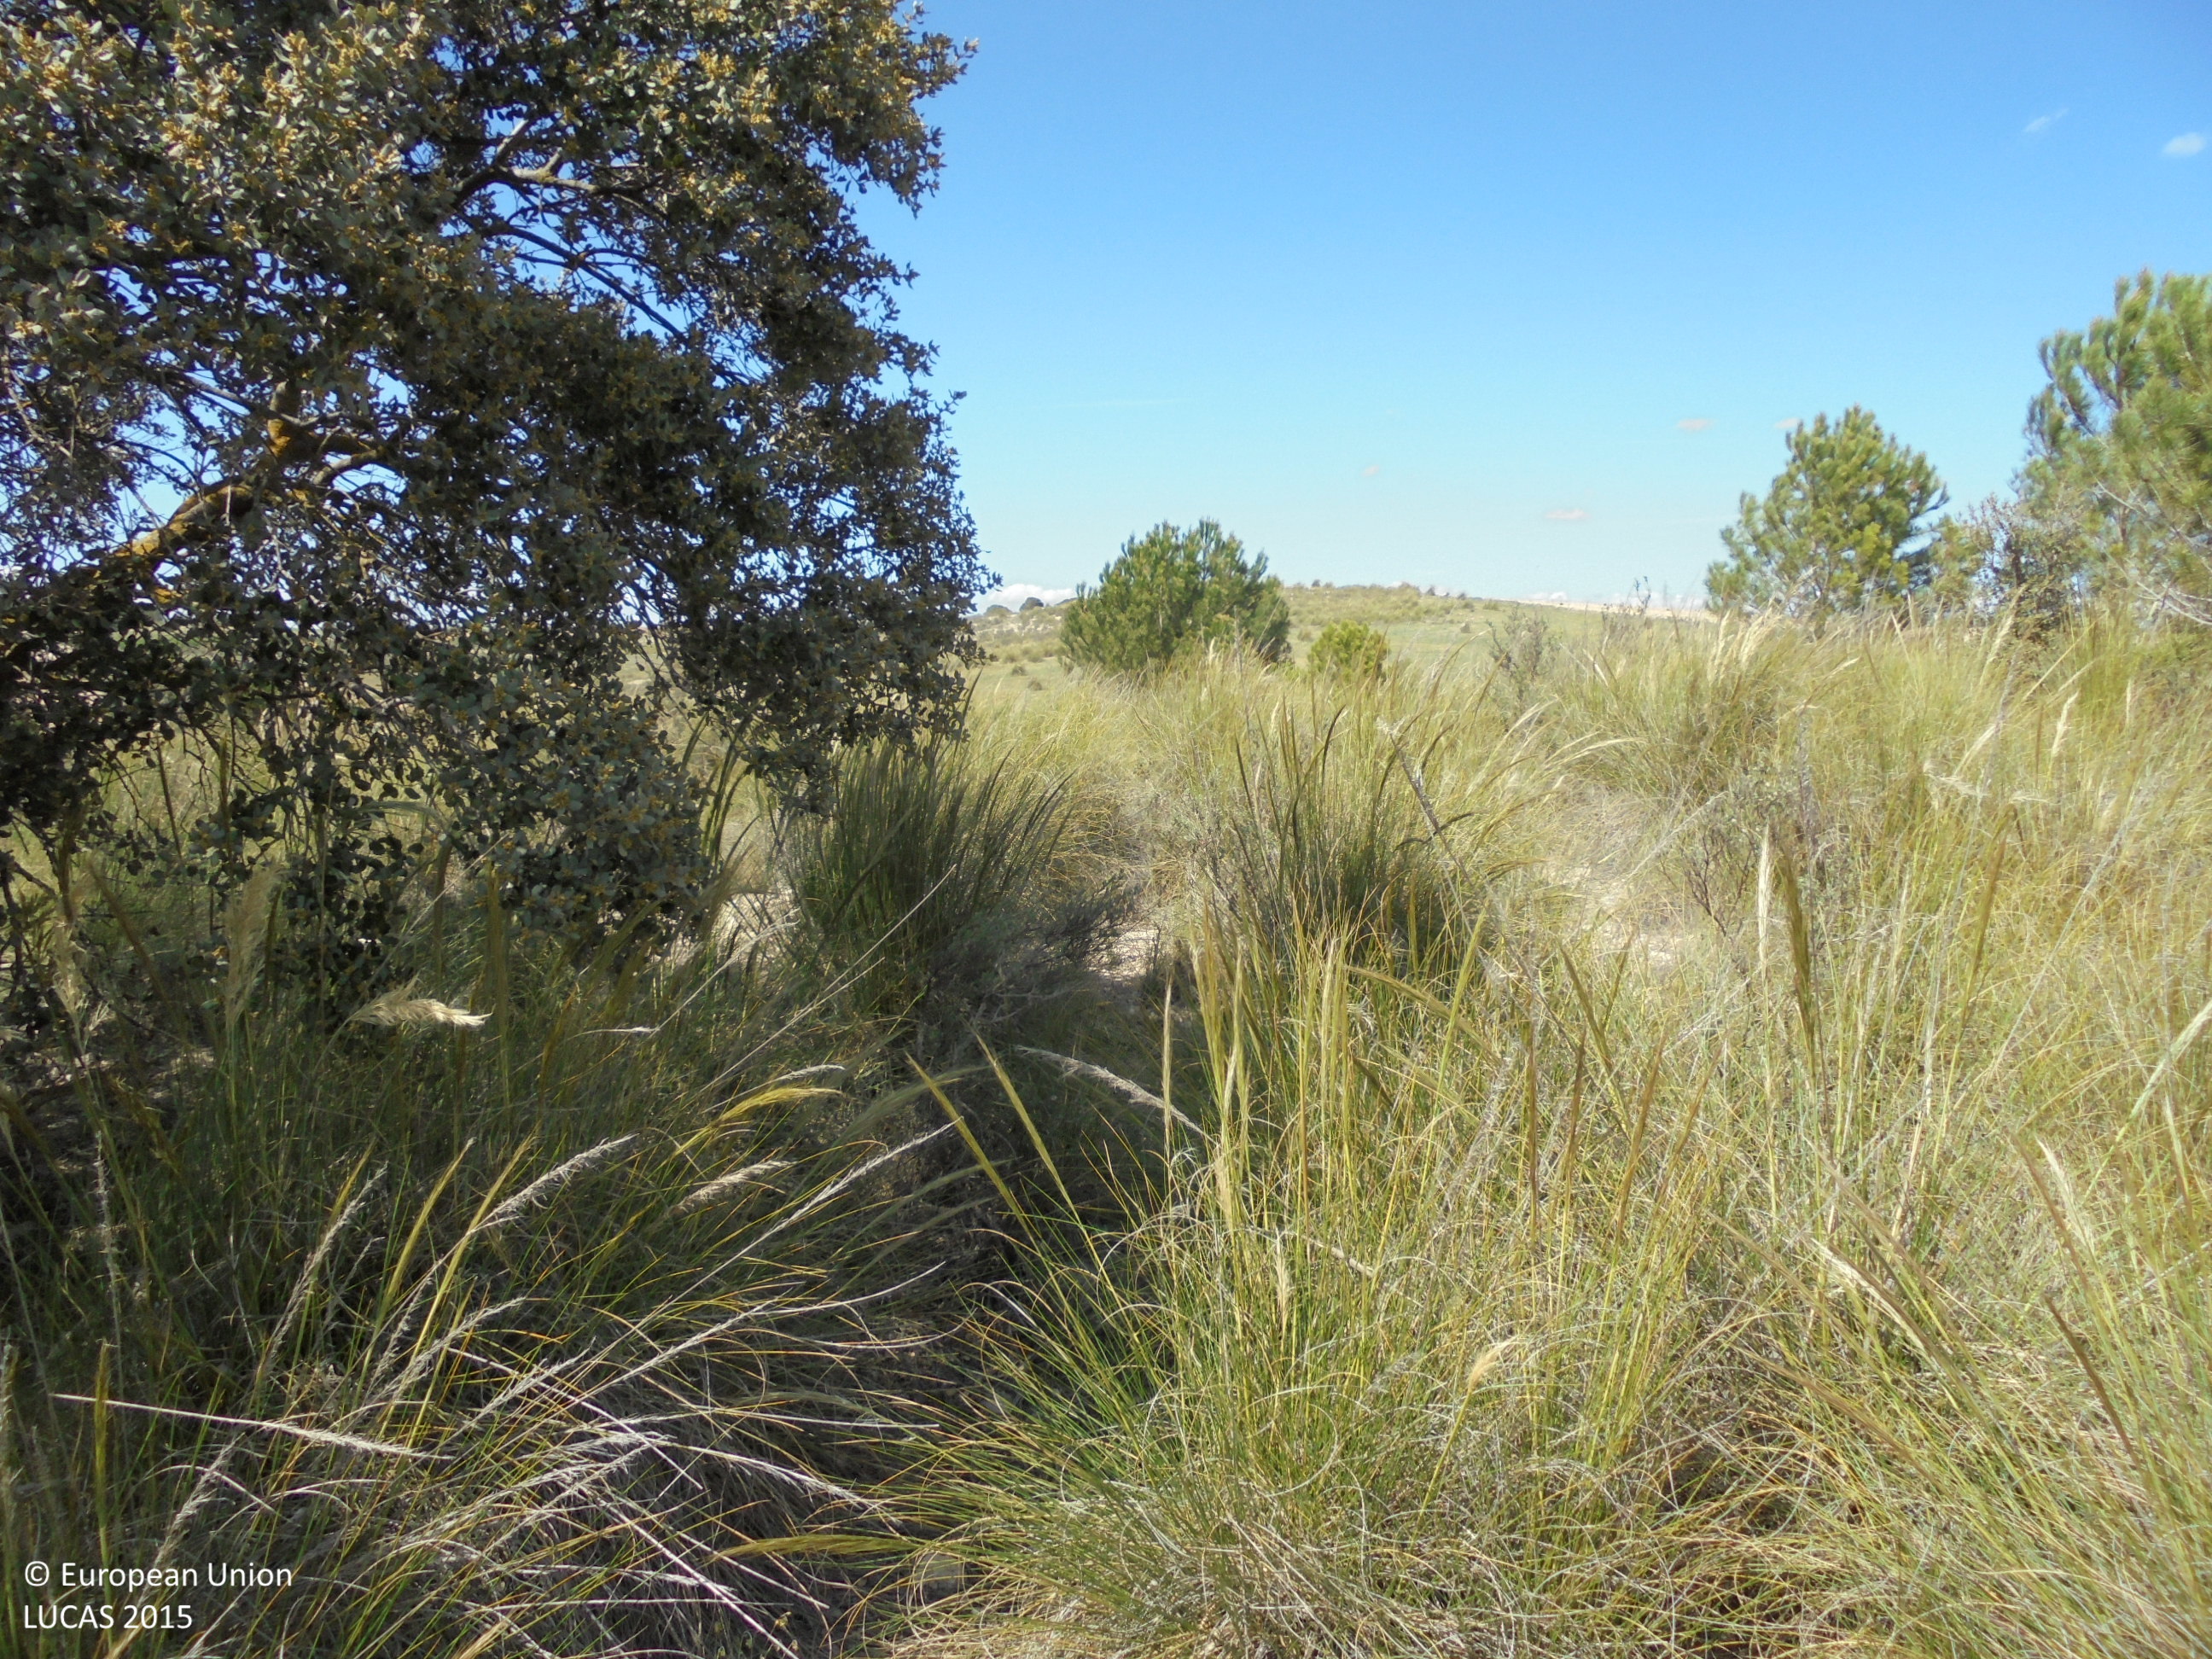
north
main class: Woodland
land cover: Pine dominated coniferous woodland
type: coniferous forest of the mediterranean region
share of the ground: 10 - 25 %
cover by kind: shrubs 60 %, coniferous forest trees 20 %, unconsolidated bare surface 20 %
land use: Semi-natural and natural areas not in use
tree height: > 5 m
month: April
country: ES
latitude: 39.1542
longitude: -1.7704
